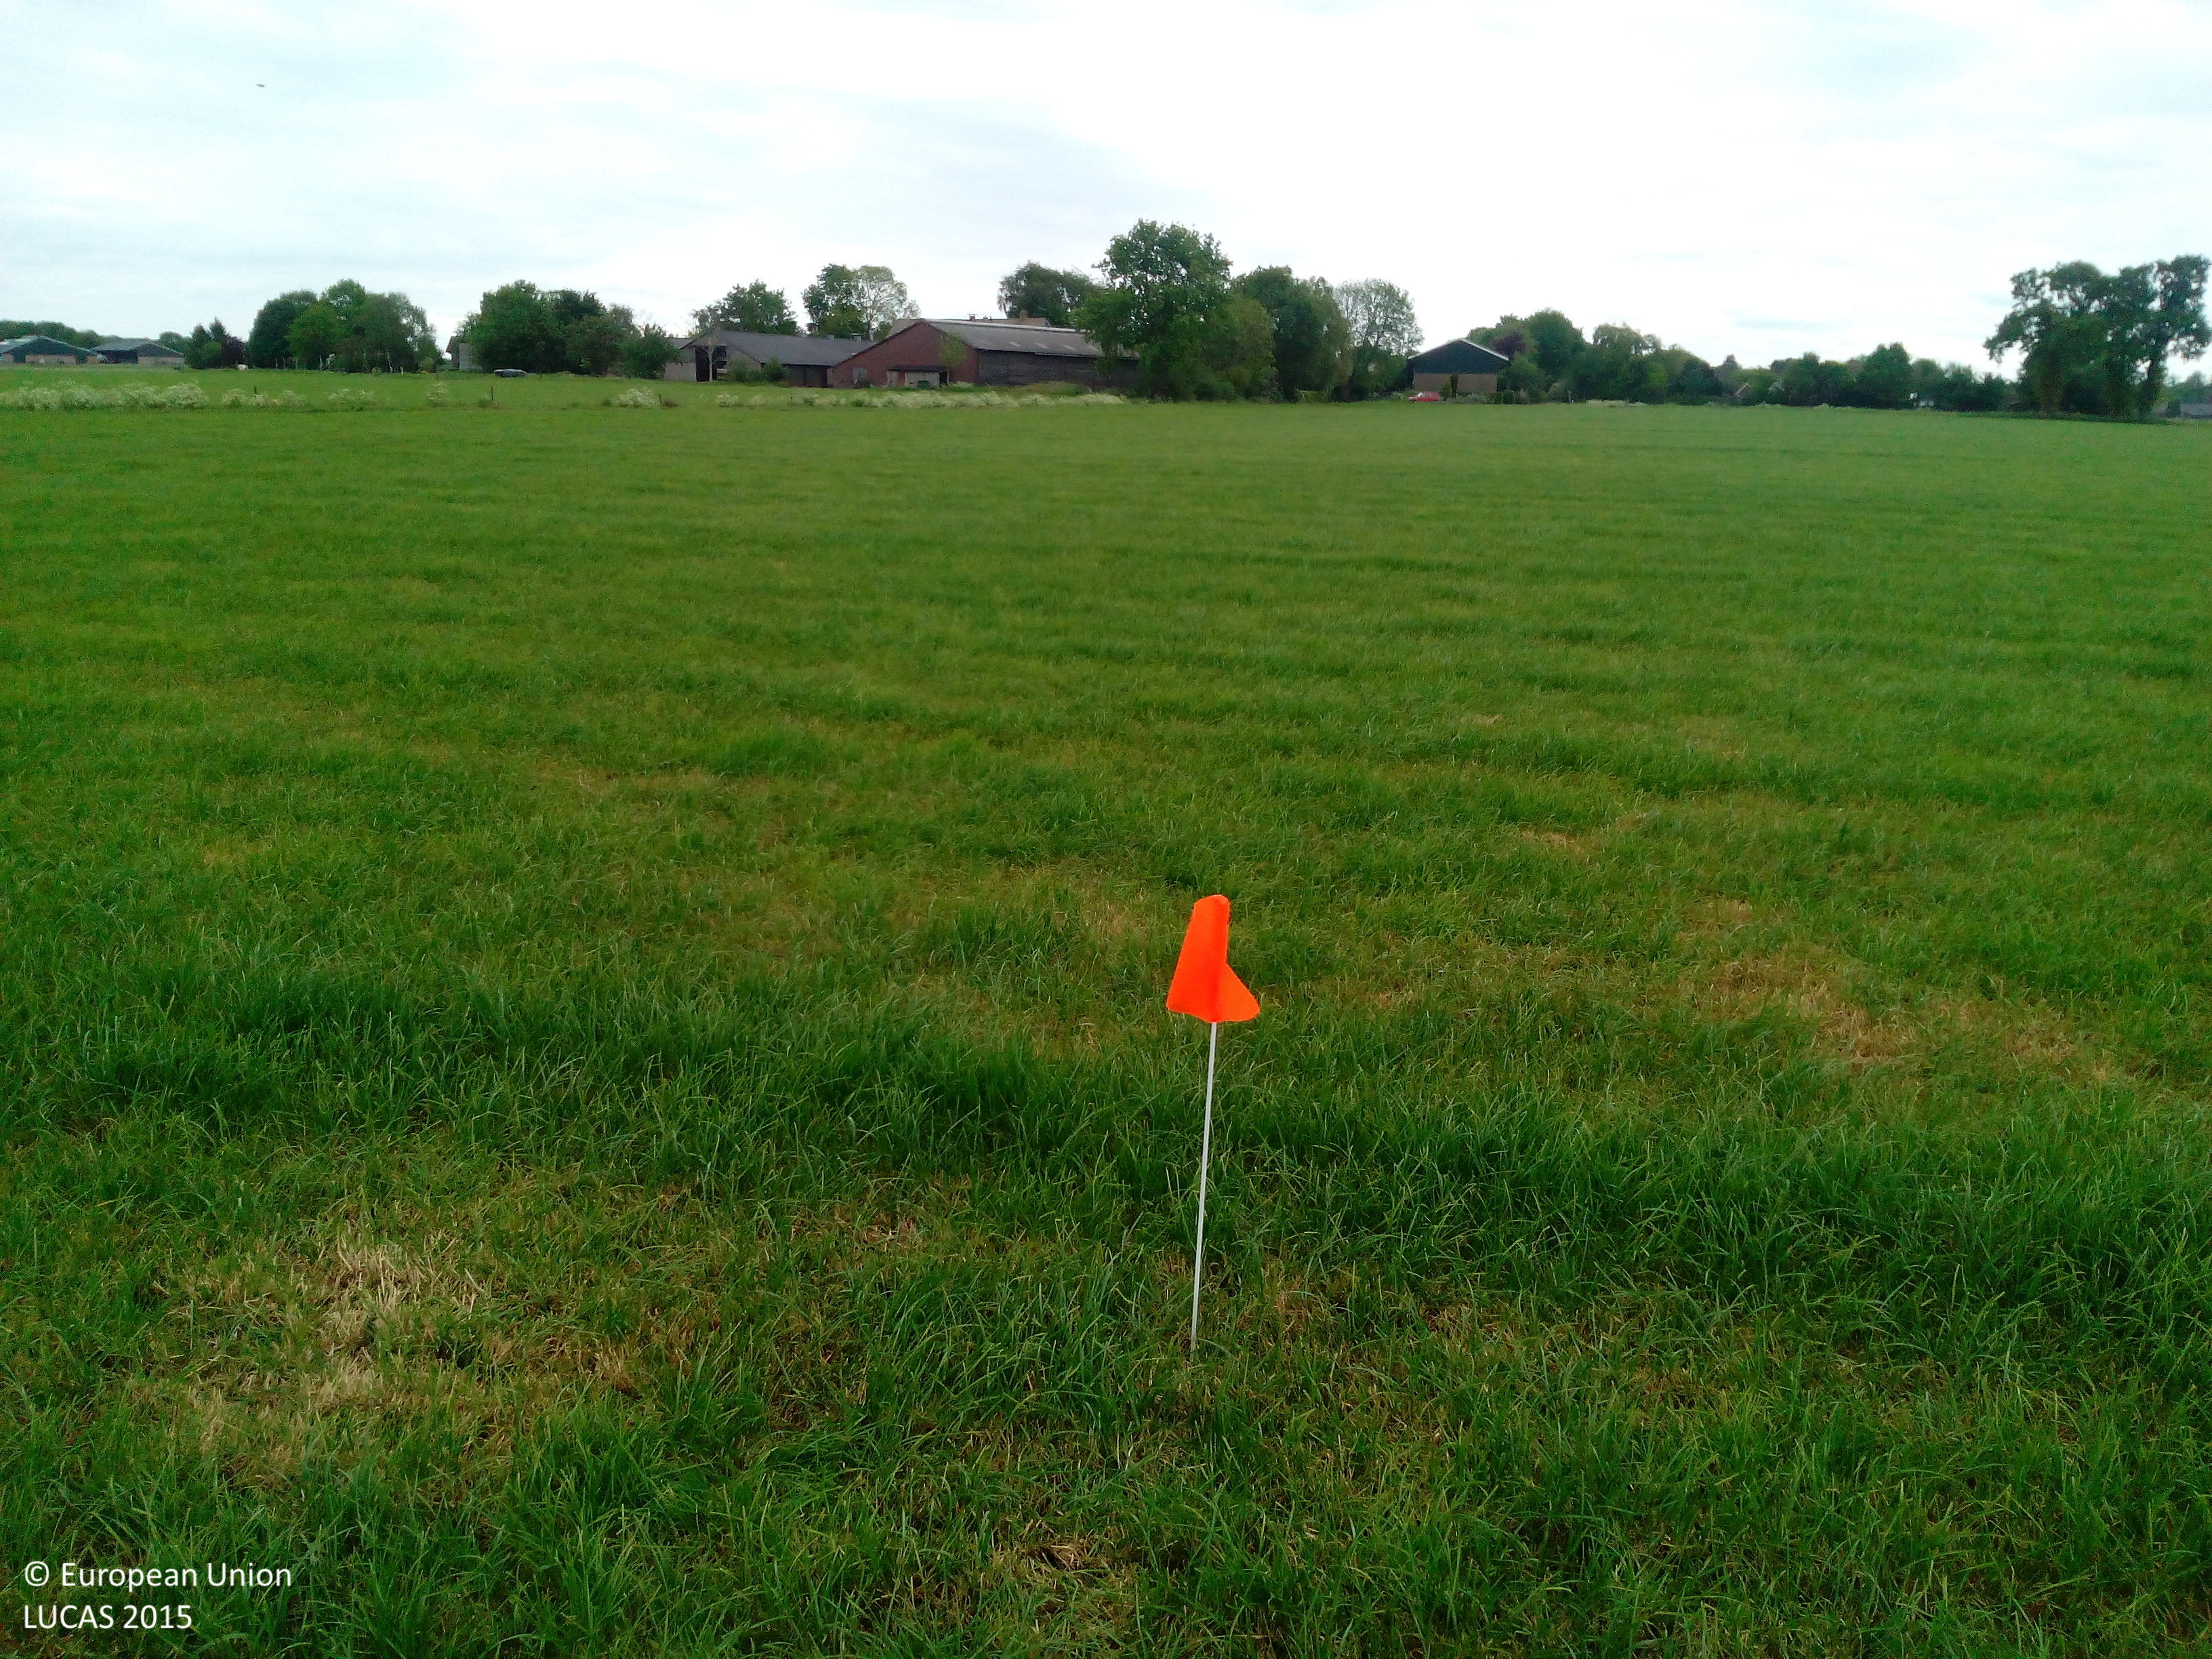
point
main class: Grassland
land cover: Grassland without tree/shrub cover
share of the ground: > 75 %
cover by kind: herbaceous plants 100 %
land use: Agriculture (excluding fallow land and kitchen gardens)
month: May
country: NL
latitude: 52.3705
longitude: 6.1953
